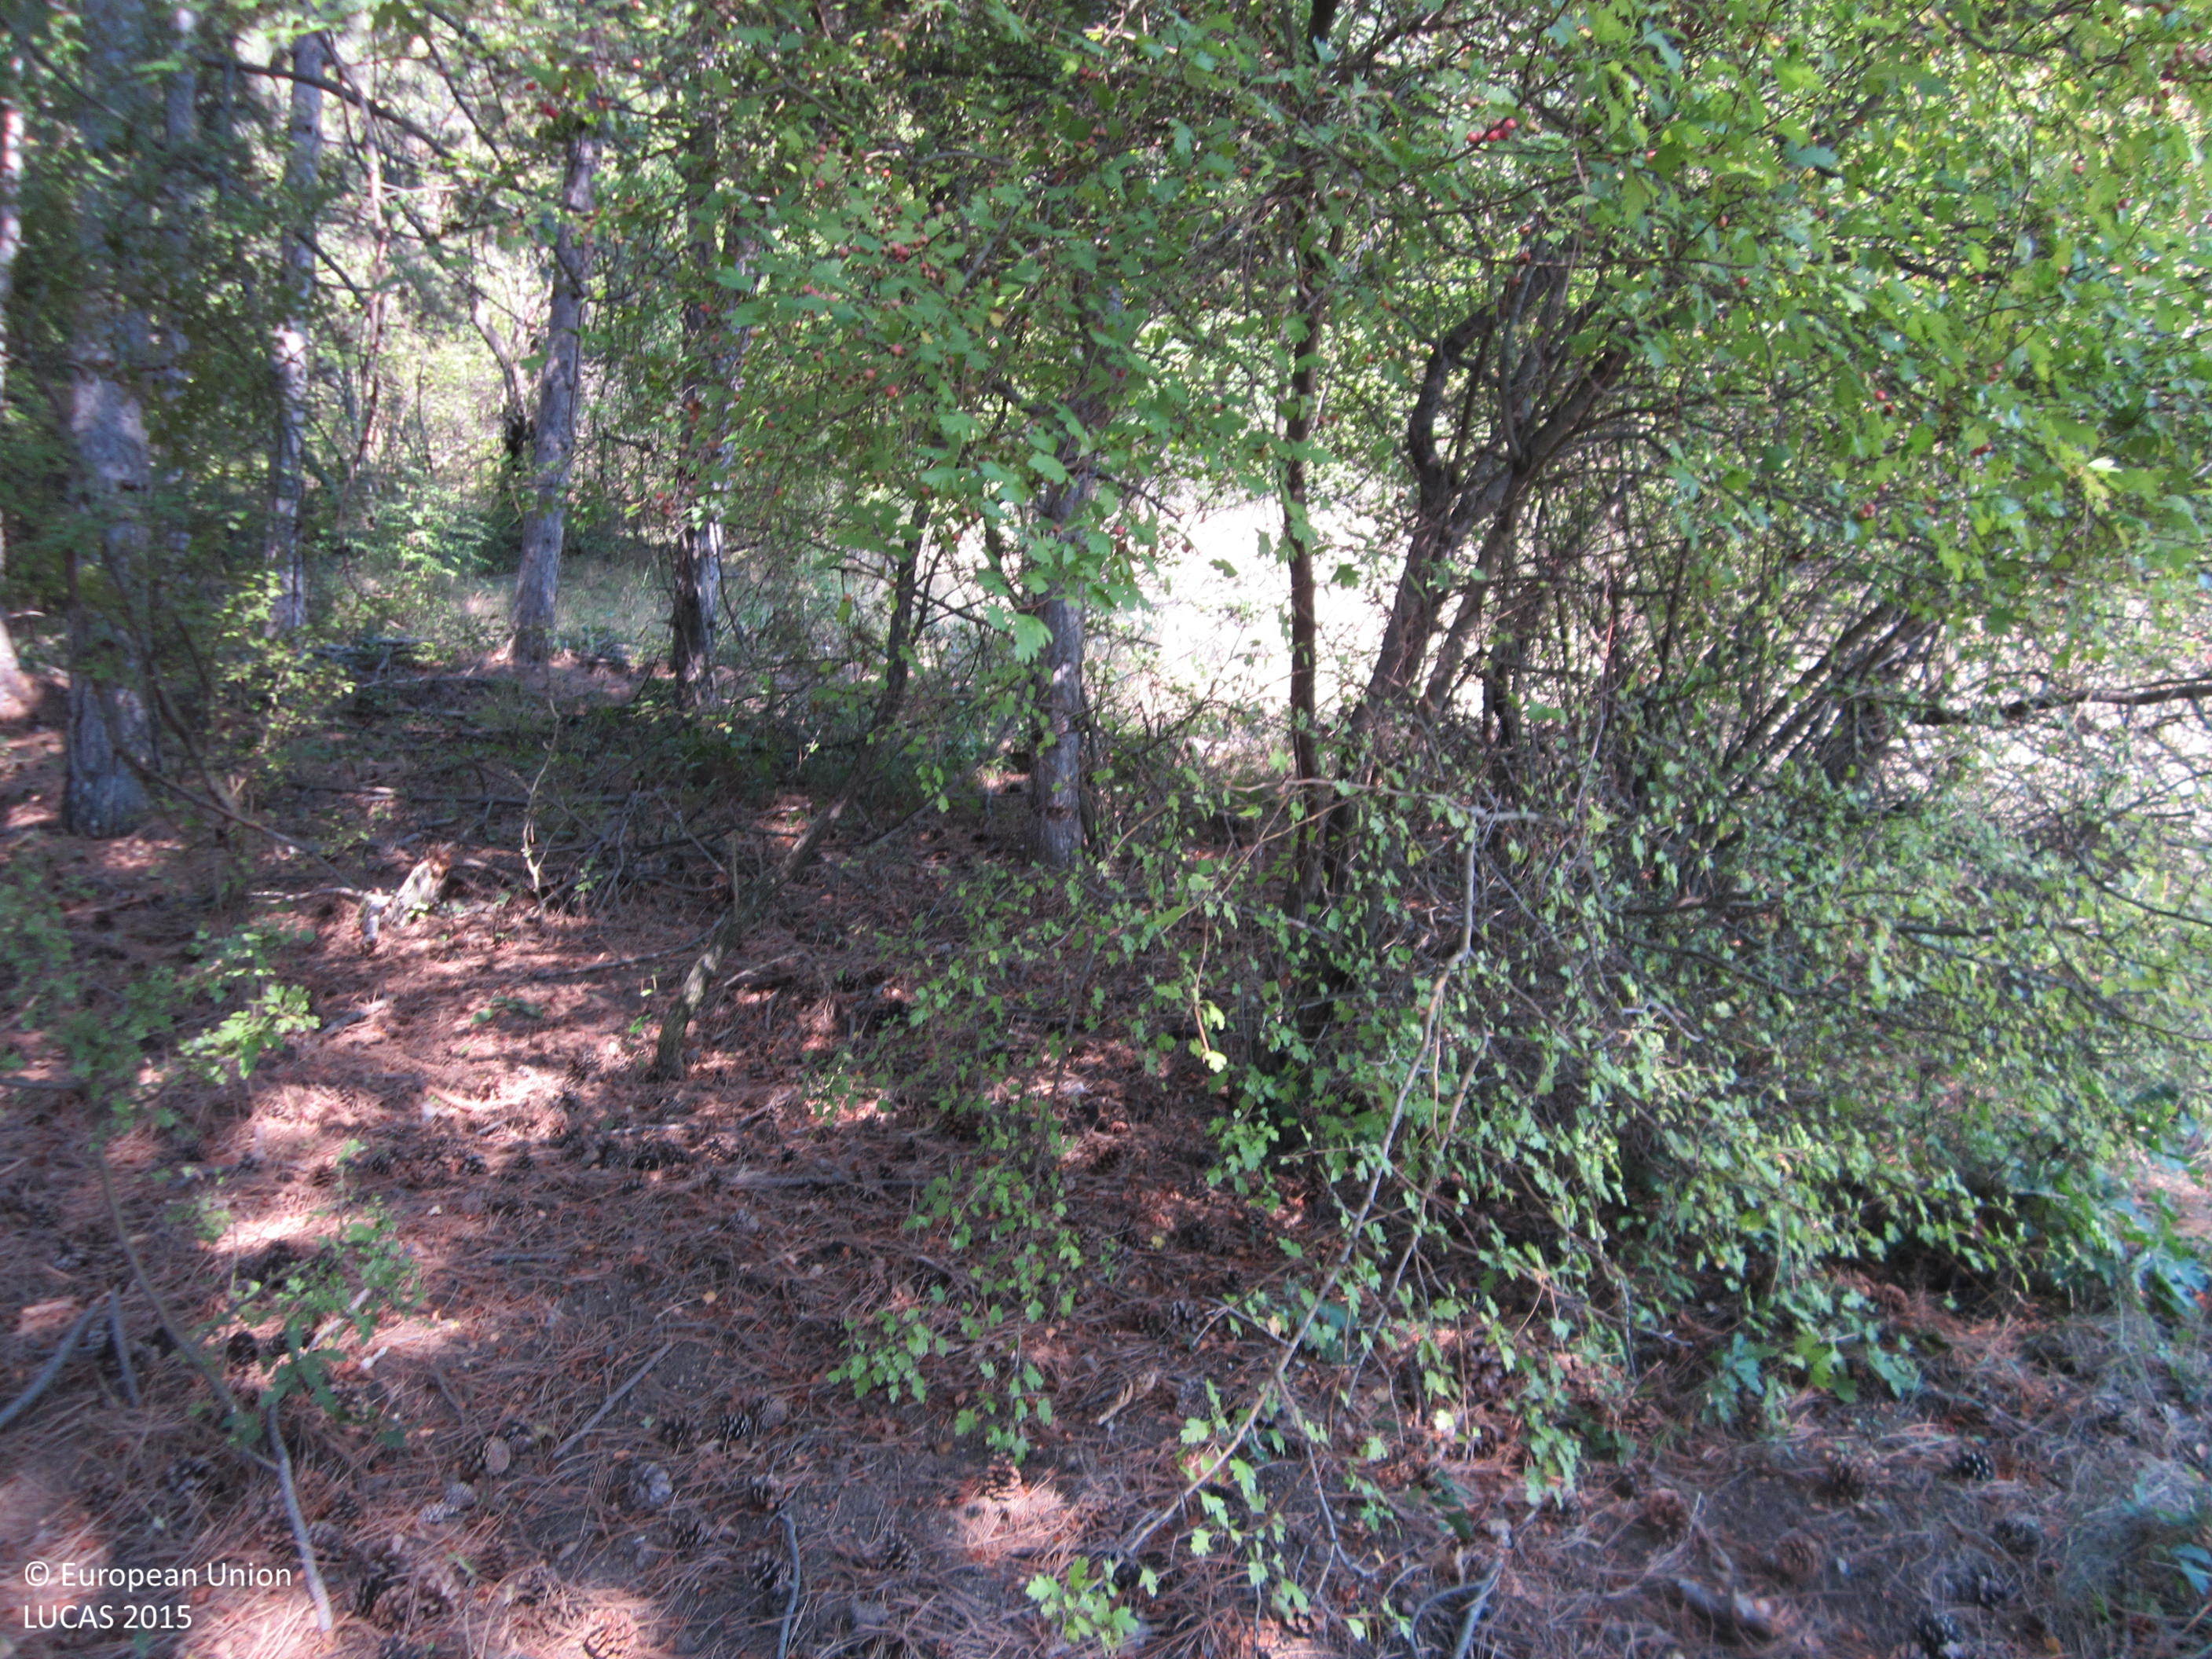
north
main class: Woodland
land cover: Pine dominated coniferous woodland
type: hemiboreal forest and nemoral coniferous forest and mixed broadleaved-coniferous forest
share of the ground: > 75 %
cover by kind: coniferous forest trees 90 %, unconsolidated bare surface 10 %
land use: Forestry
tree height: > 5 m
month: September
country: BG
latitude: 42.8542
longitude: 26.9347
